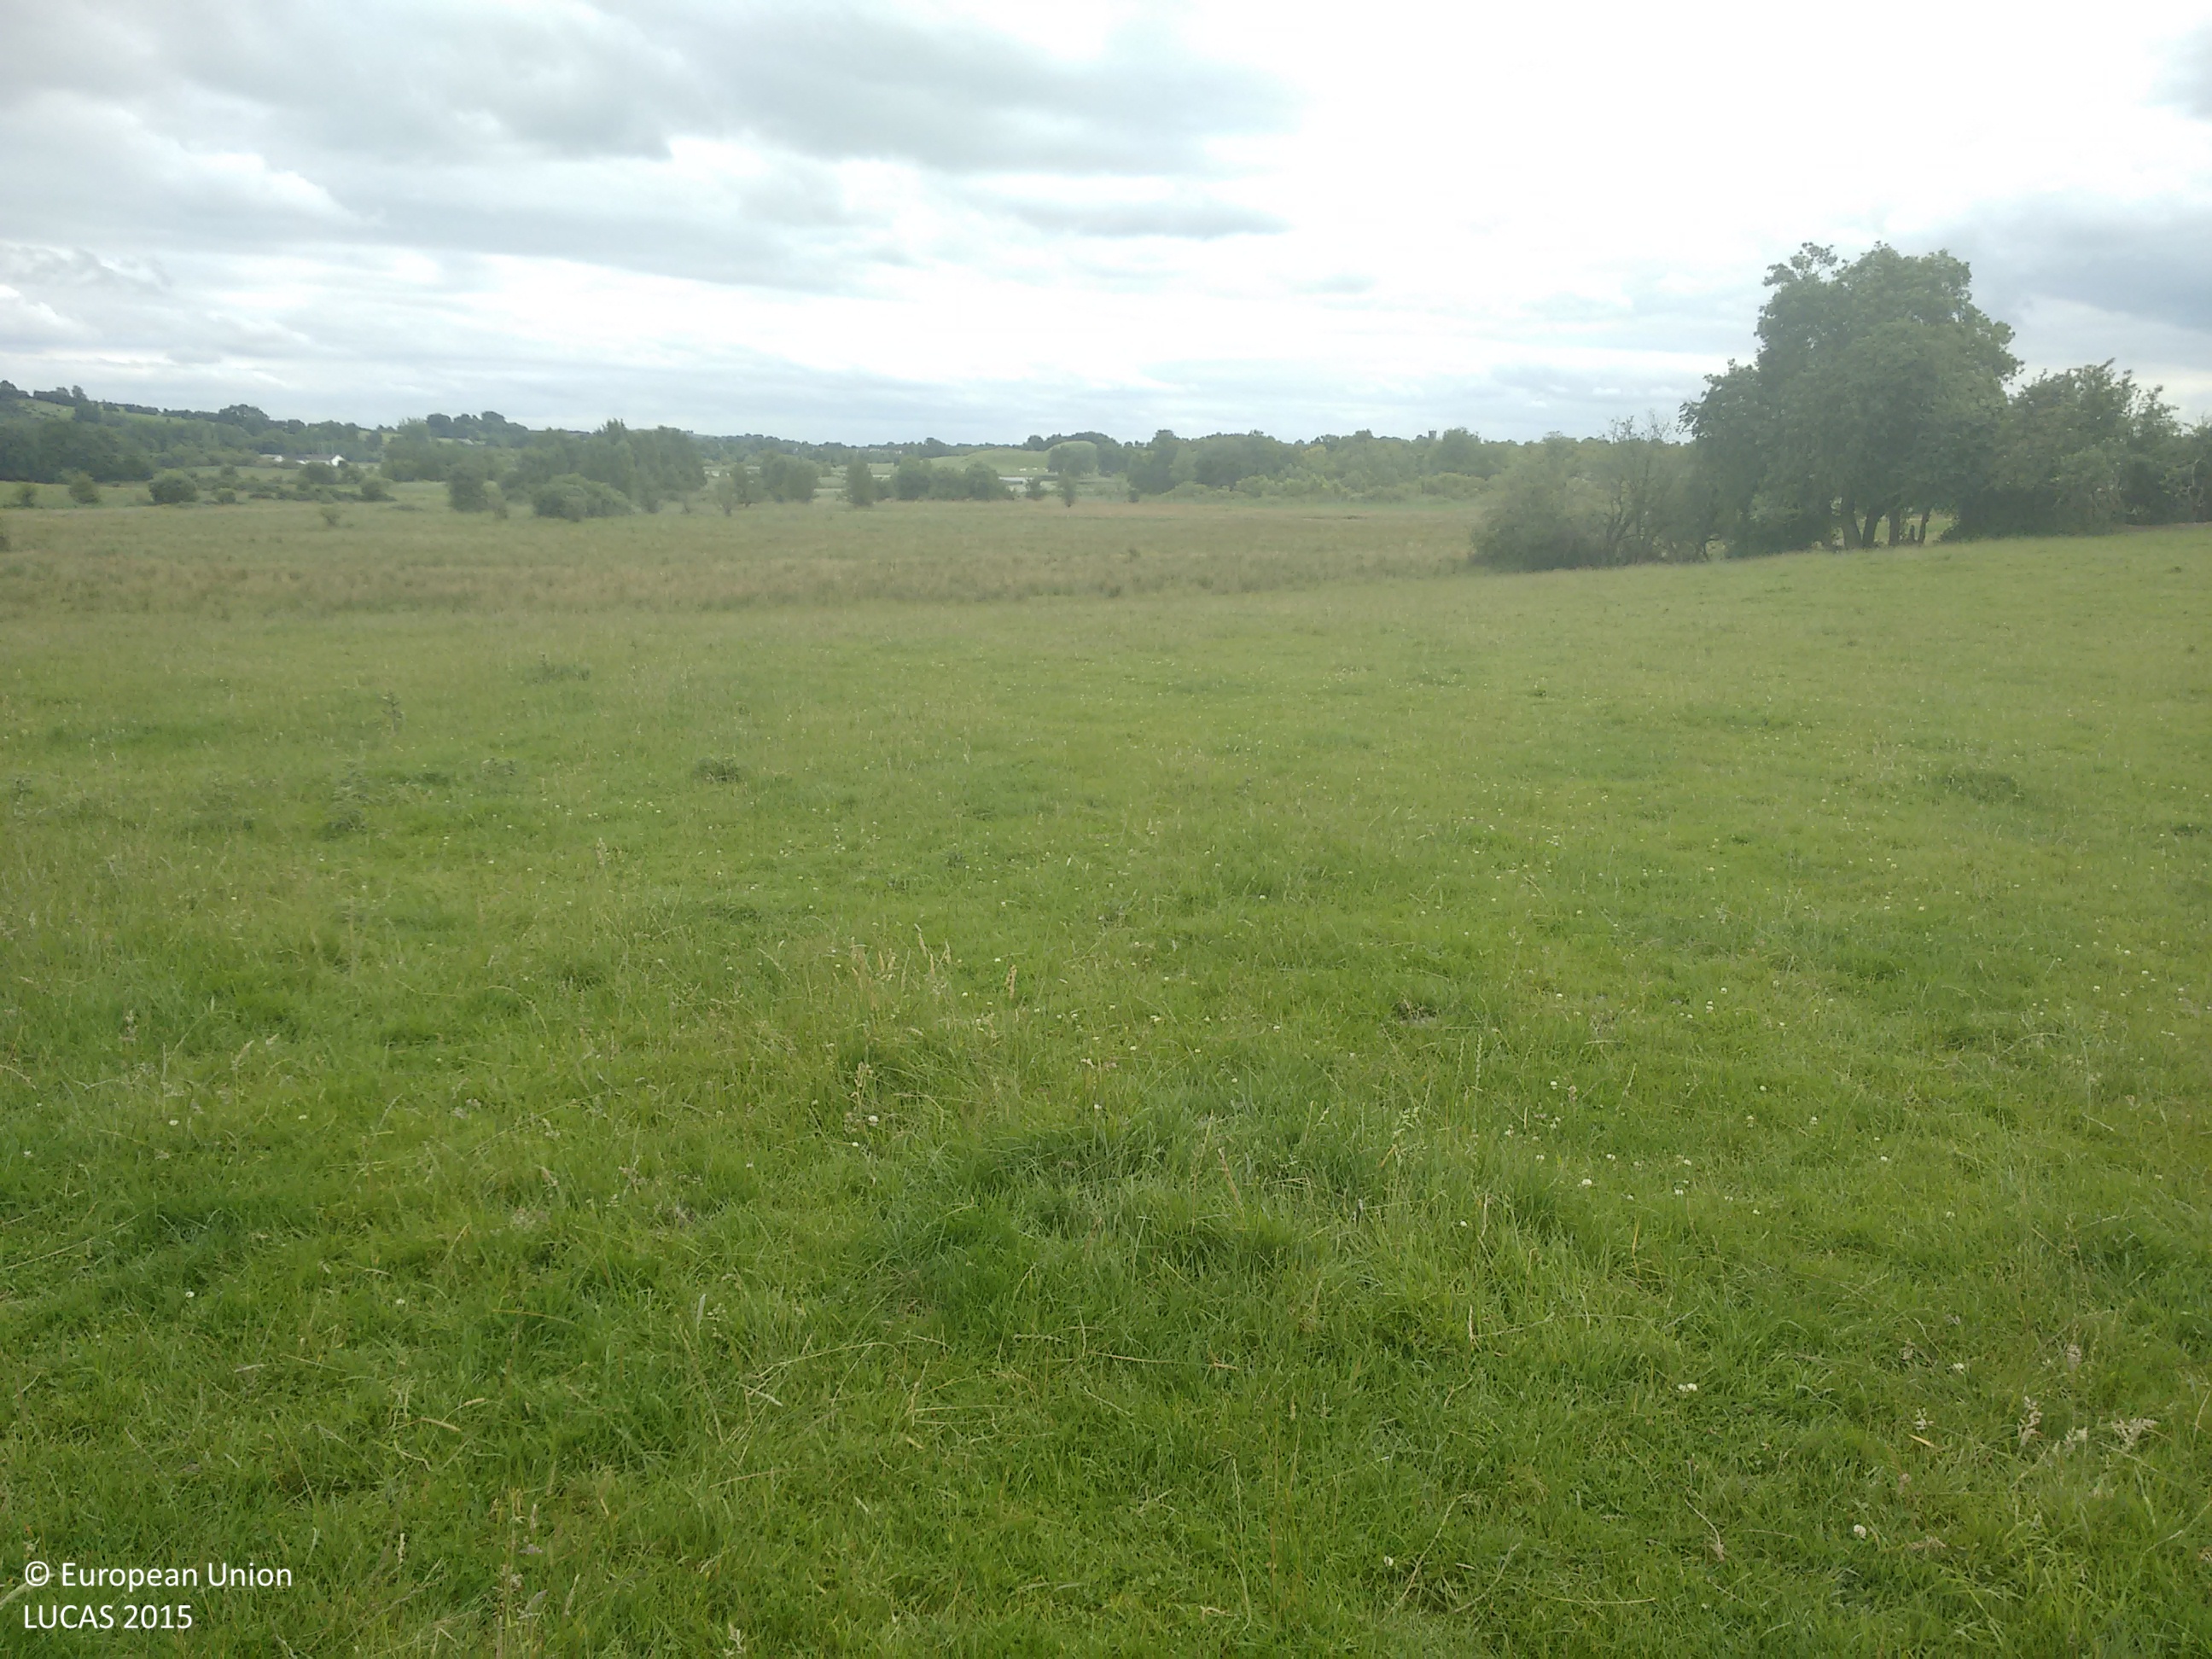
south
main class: Grassland
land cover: Grassland without tree/shrub cover
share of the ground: > 75 %
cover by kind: herbaceous plants 100 %
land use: Agriculture (excluding fallow land and kitchen gardens)
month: July
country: IE
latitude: 53.5069
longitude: -7.6691
